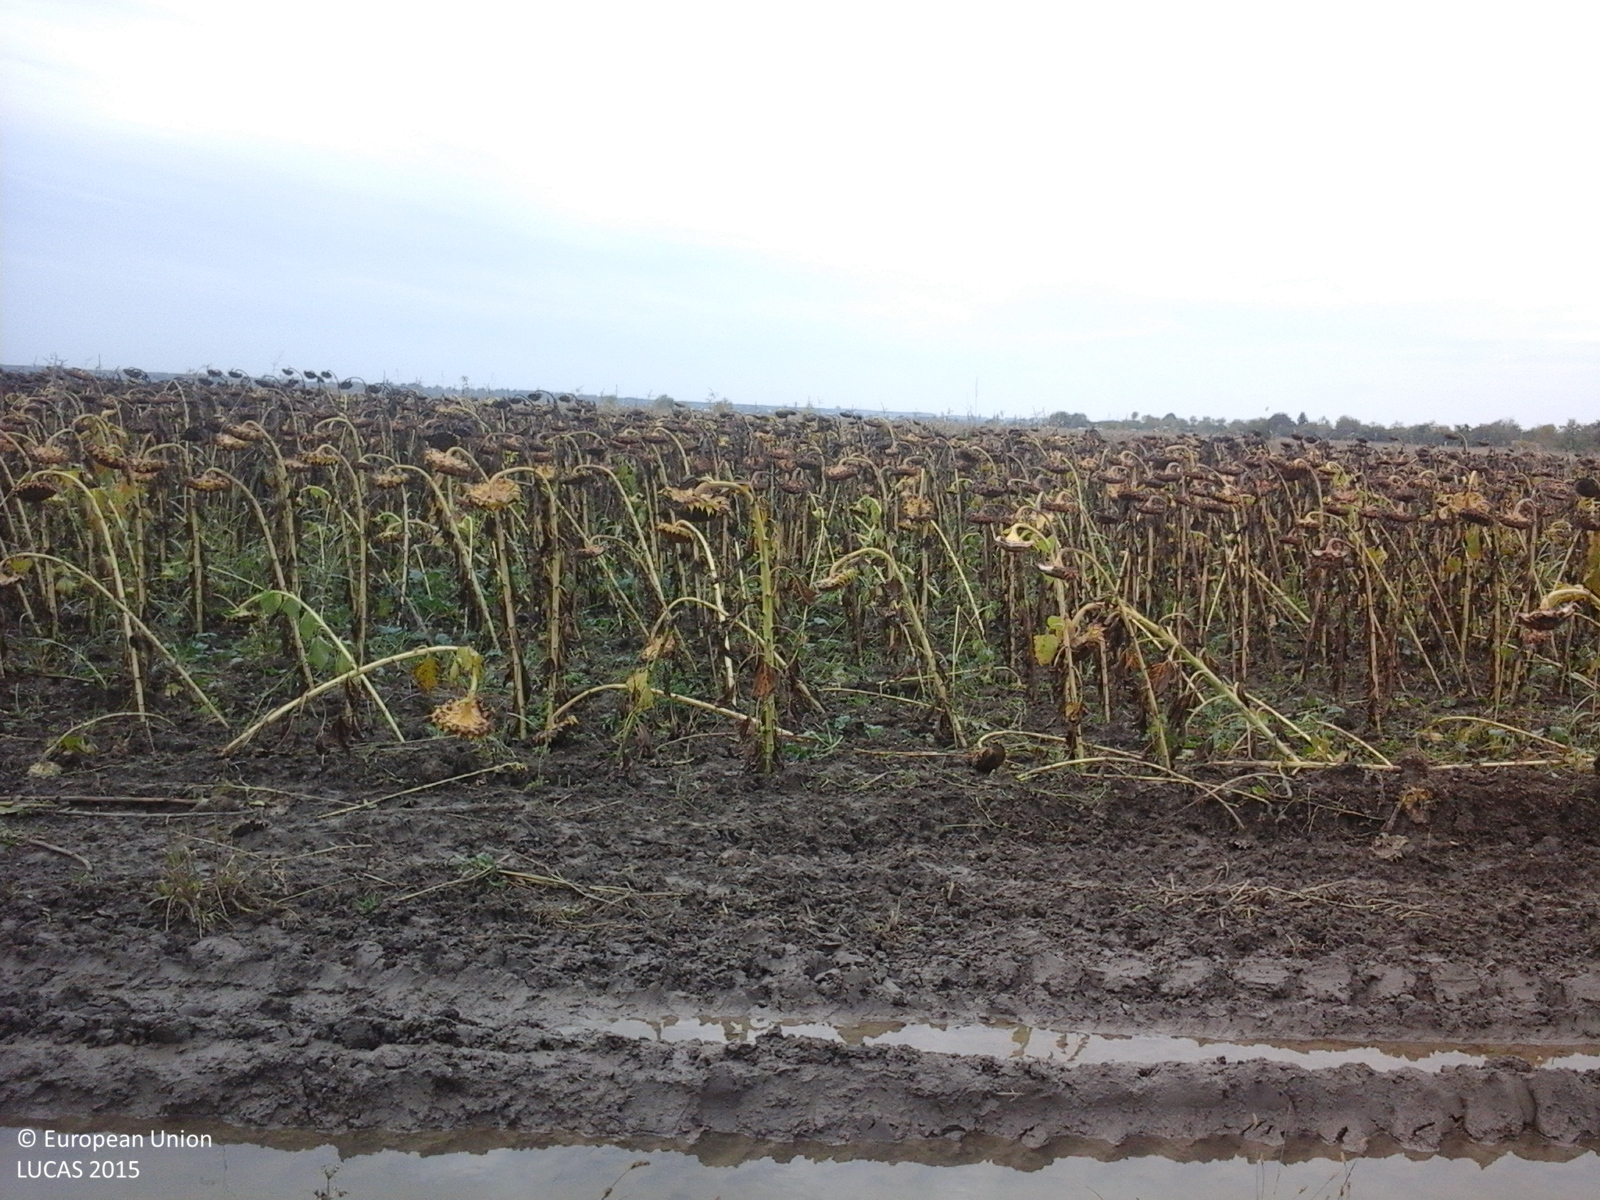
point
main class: Cropland
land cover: Sunflower
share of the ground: > 75 %
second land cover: Spontaneously vegetated surfaces
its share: 25 - 50 %
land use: Agriculture (excluding fallow land and kitchen gardens)
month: October
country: RO
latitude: 44.8810
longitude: 26.2285
